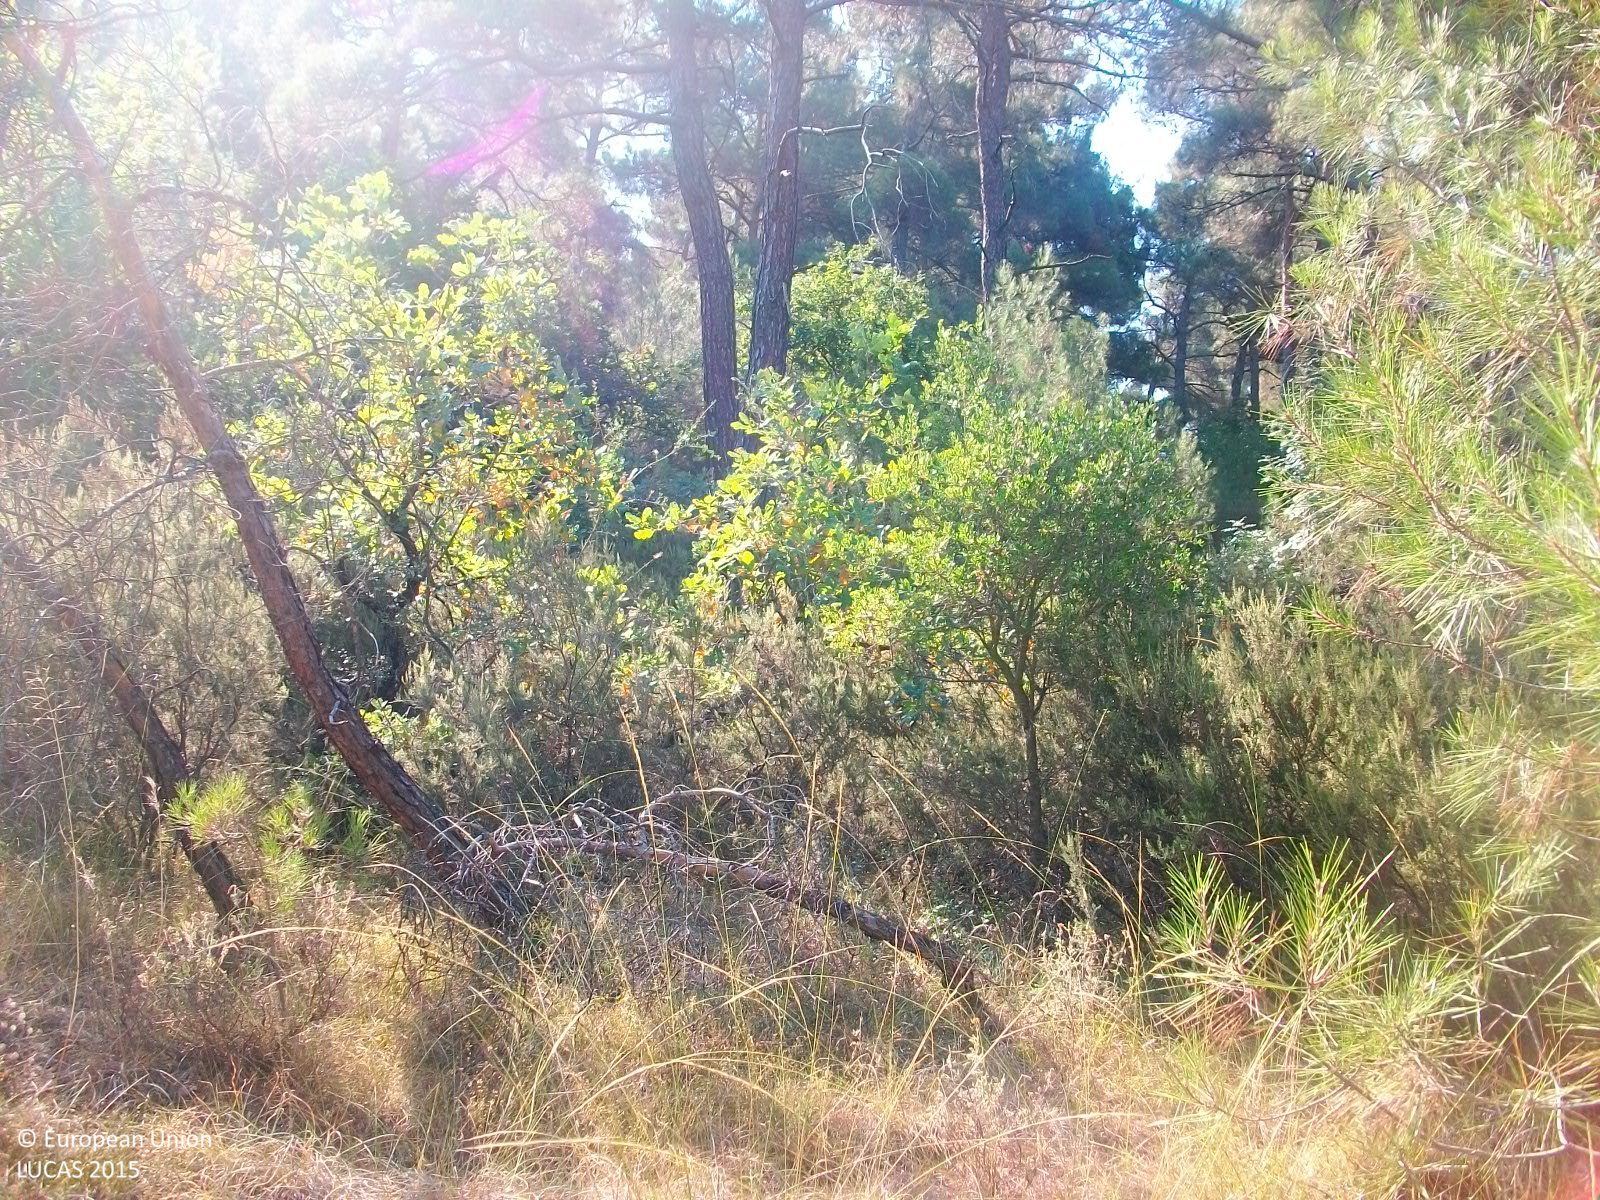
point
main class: Woodland
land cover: Pine dominated coniferous woodland
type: coniferous forest of the mediterranean region
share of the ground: > 75 %
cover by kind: coniferous forest trees 90 %, shrubs 5 %, herbaceous plants 5 %
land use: Forestry
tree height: > 5 m
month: July
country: GR
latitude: 41.0969
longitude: 26.2232
